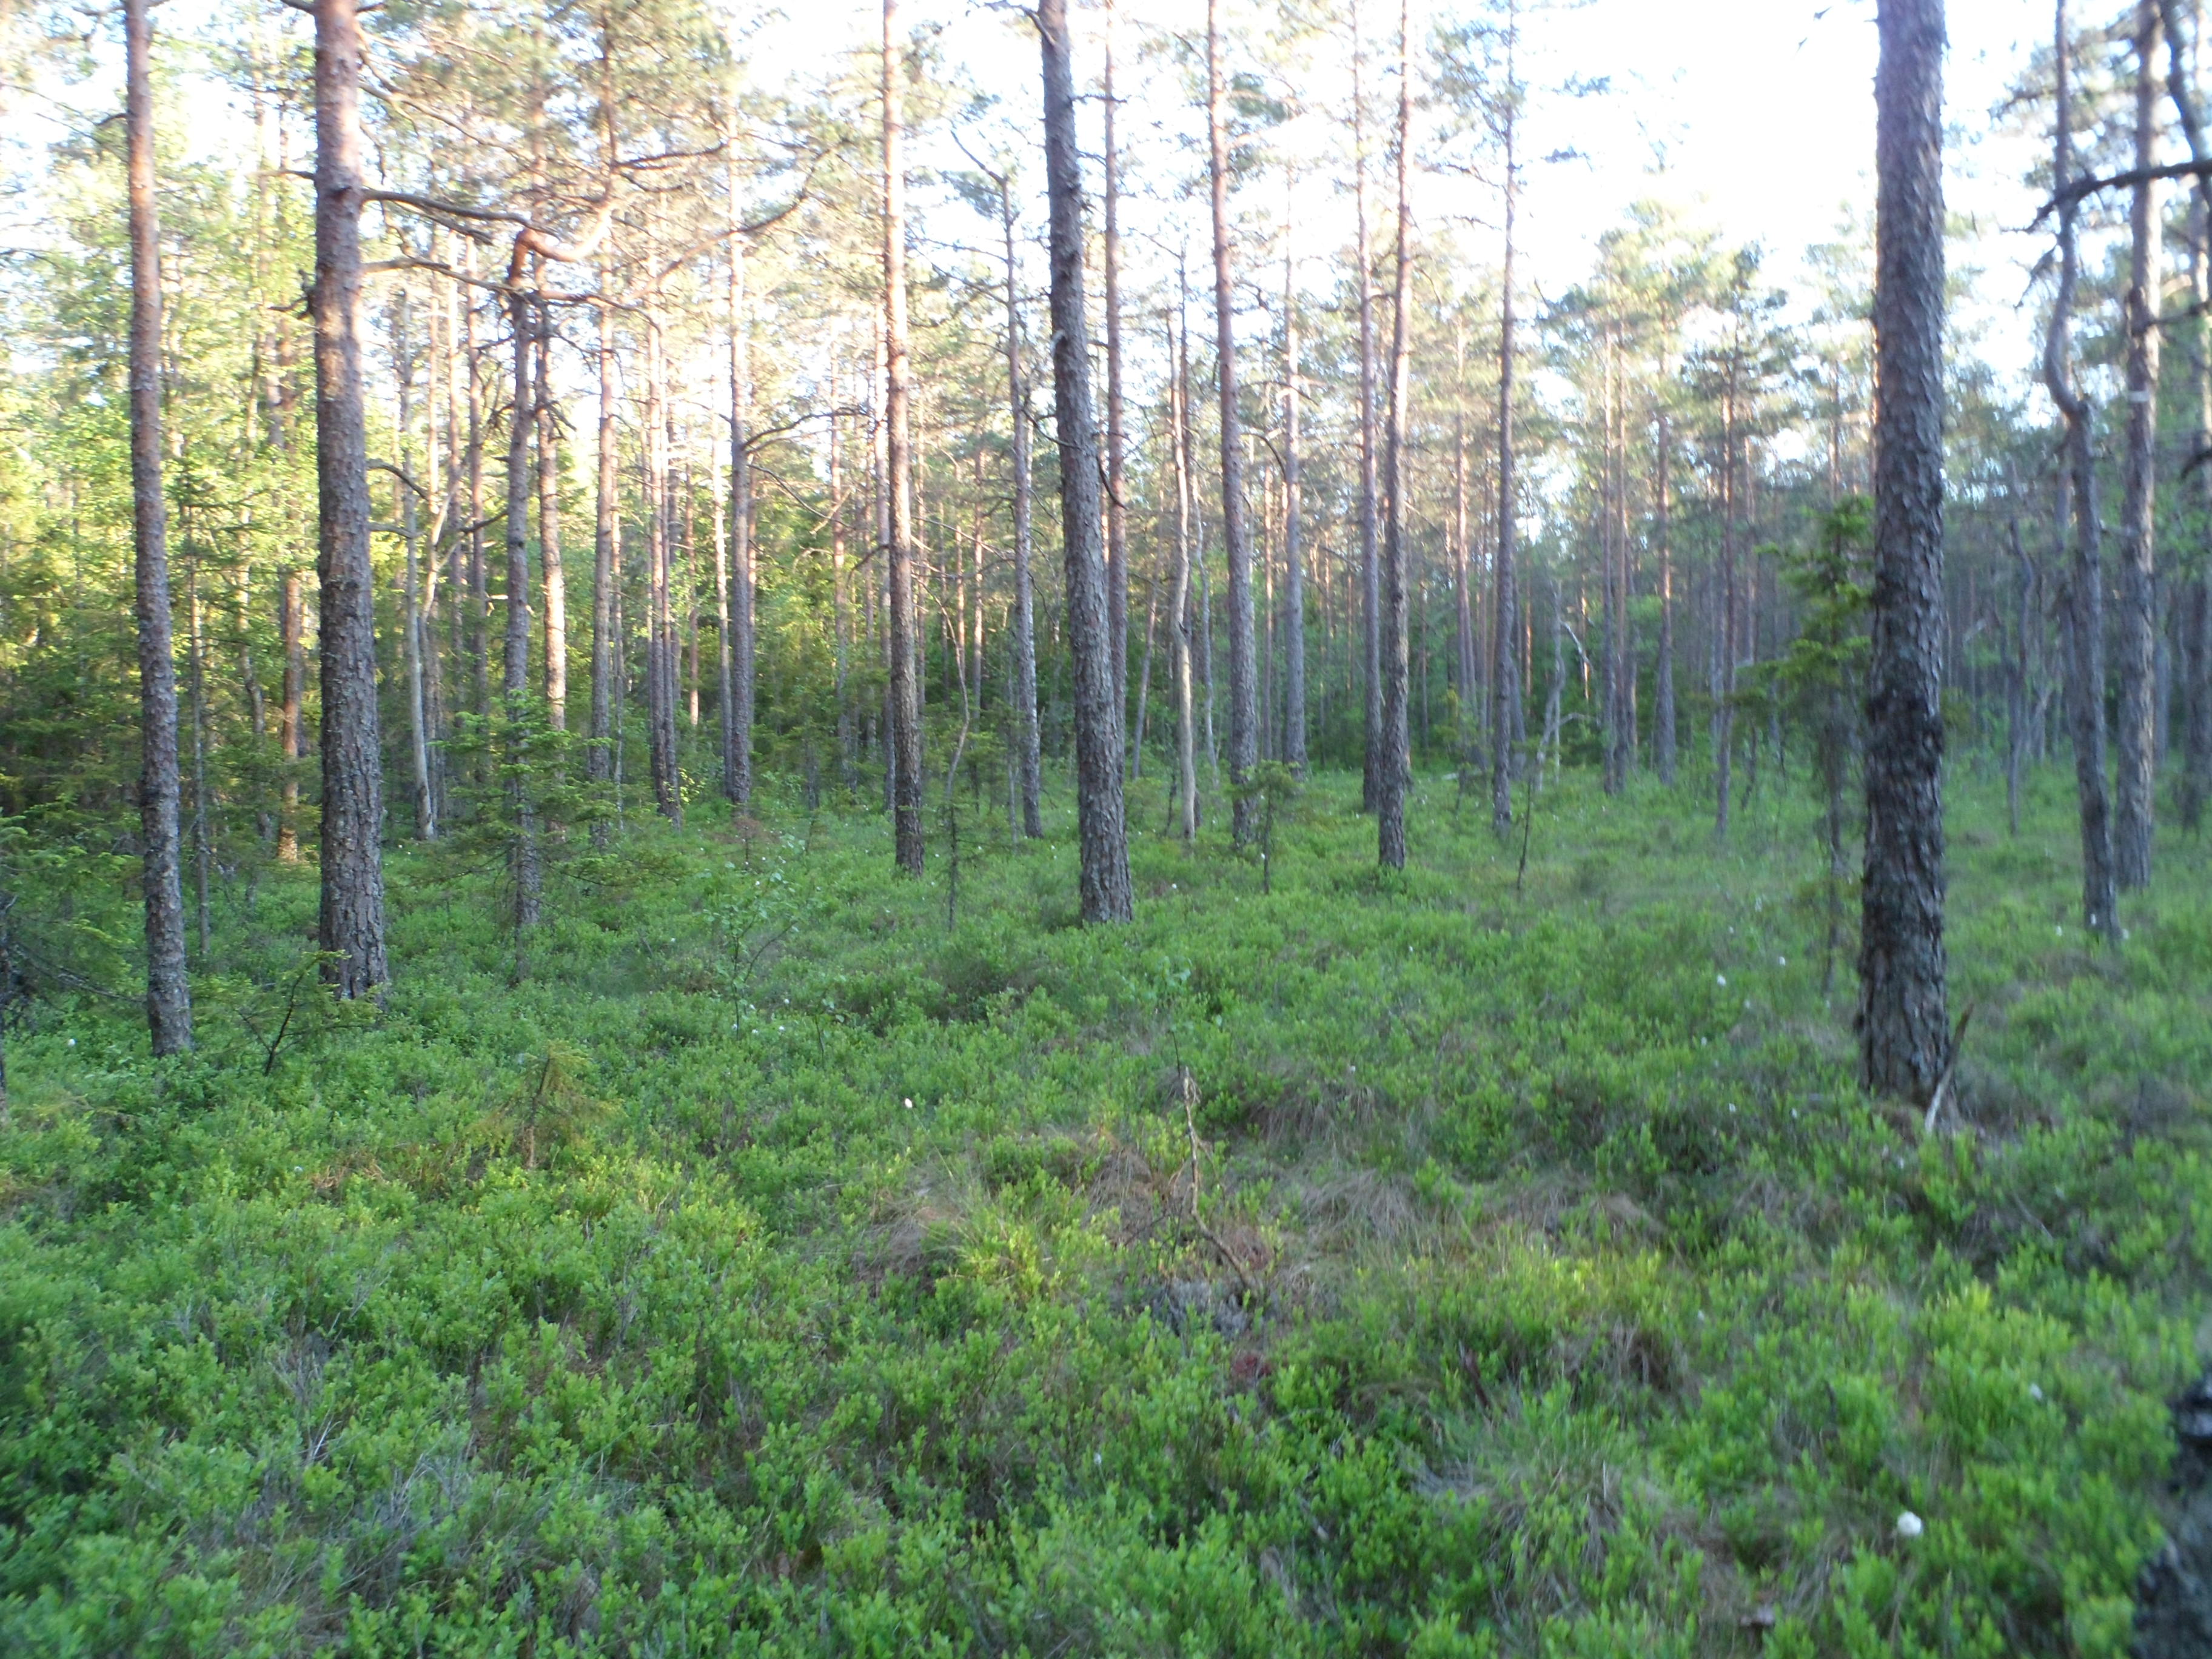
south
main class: Woodland
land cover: Pine dominated coniferous woodland
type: boreal forest
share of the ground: 25 - 50 %
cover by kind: coniferous forest trees 40 %, shrubs 25 %, herbaceous plants 15 %, lichens and mosses 15 %, broadleaved forest trees 5 %
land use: Forestry
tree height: > 5 m
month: June
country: SE
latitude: 57.4962
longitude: 13.9166
